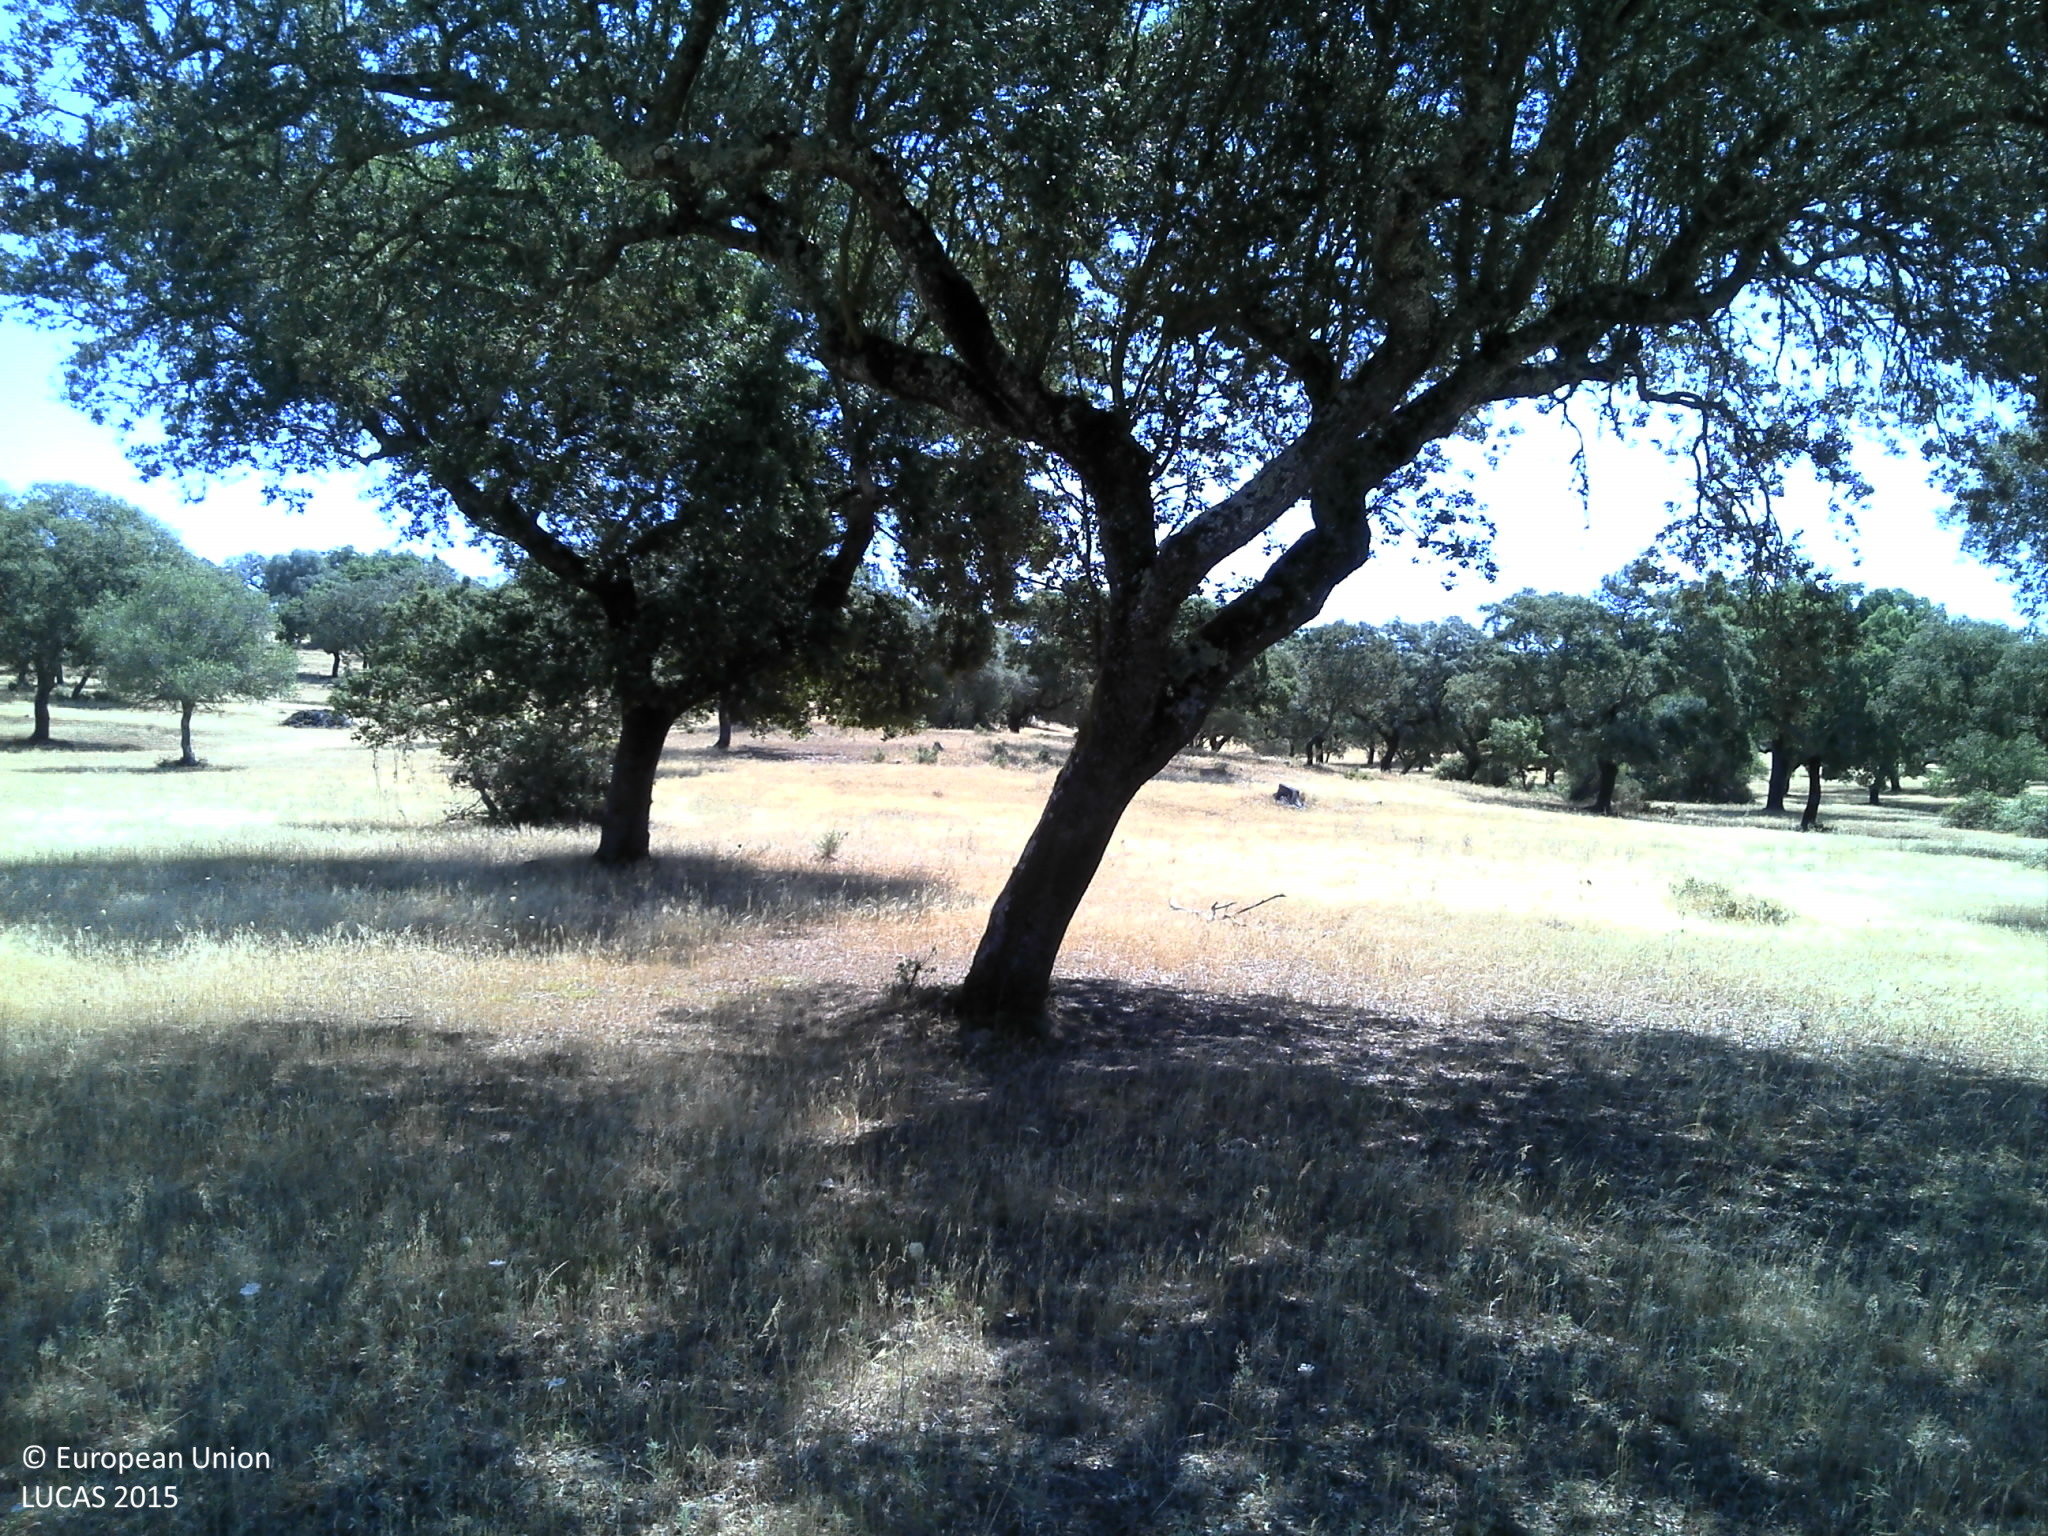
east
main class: Woodland
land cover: Broadleaved woodland
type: broadleaved evergreen forest
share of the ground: 25 - 50 %
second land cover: Grassland without tree/shrub cover
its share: 25 - 50 %
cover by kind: unconsolidated bare surface 45 %, broadleaved forest trees 30 %, herbaceous plants 25 %
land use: Forestry
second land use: Agriculture (excluding fallow land and kitchen gardens)
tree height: > 5 m
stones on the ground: < 10 %
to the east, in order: Broadleaved woodland; Grassland without tree/shrub cover; Broadleaved woodland; Rivers and streams; Broadleaved woodland
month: June
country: PT
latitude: 38.4192
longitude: -8.1037
